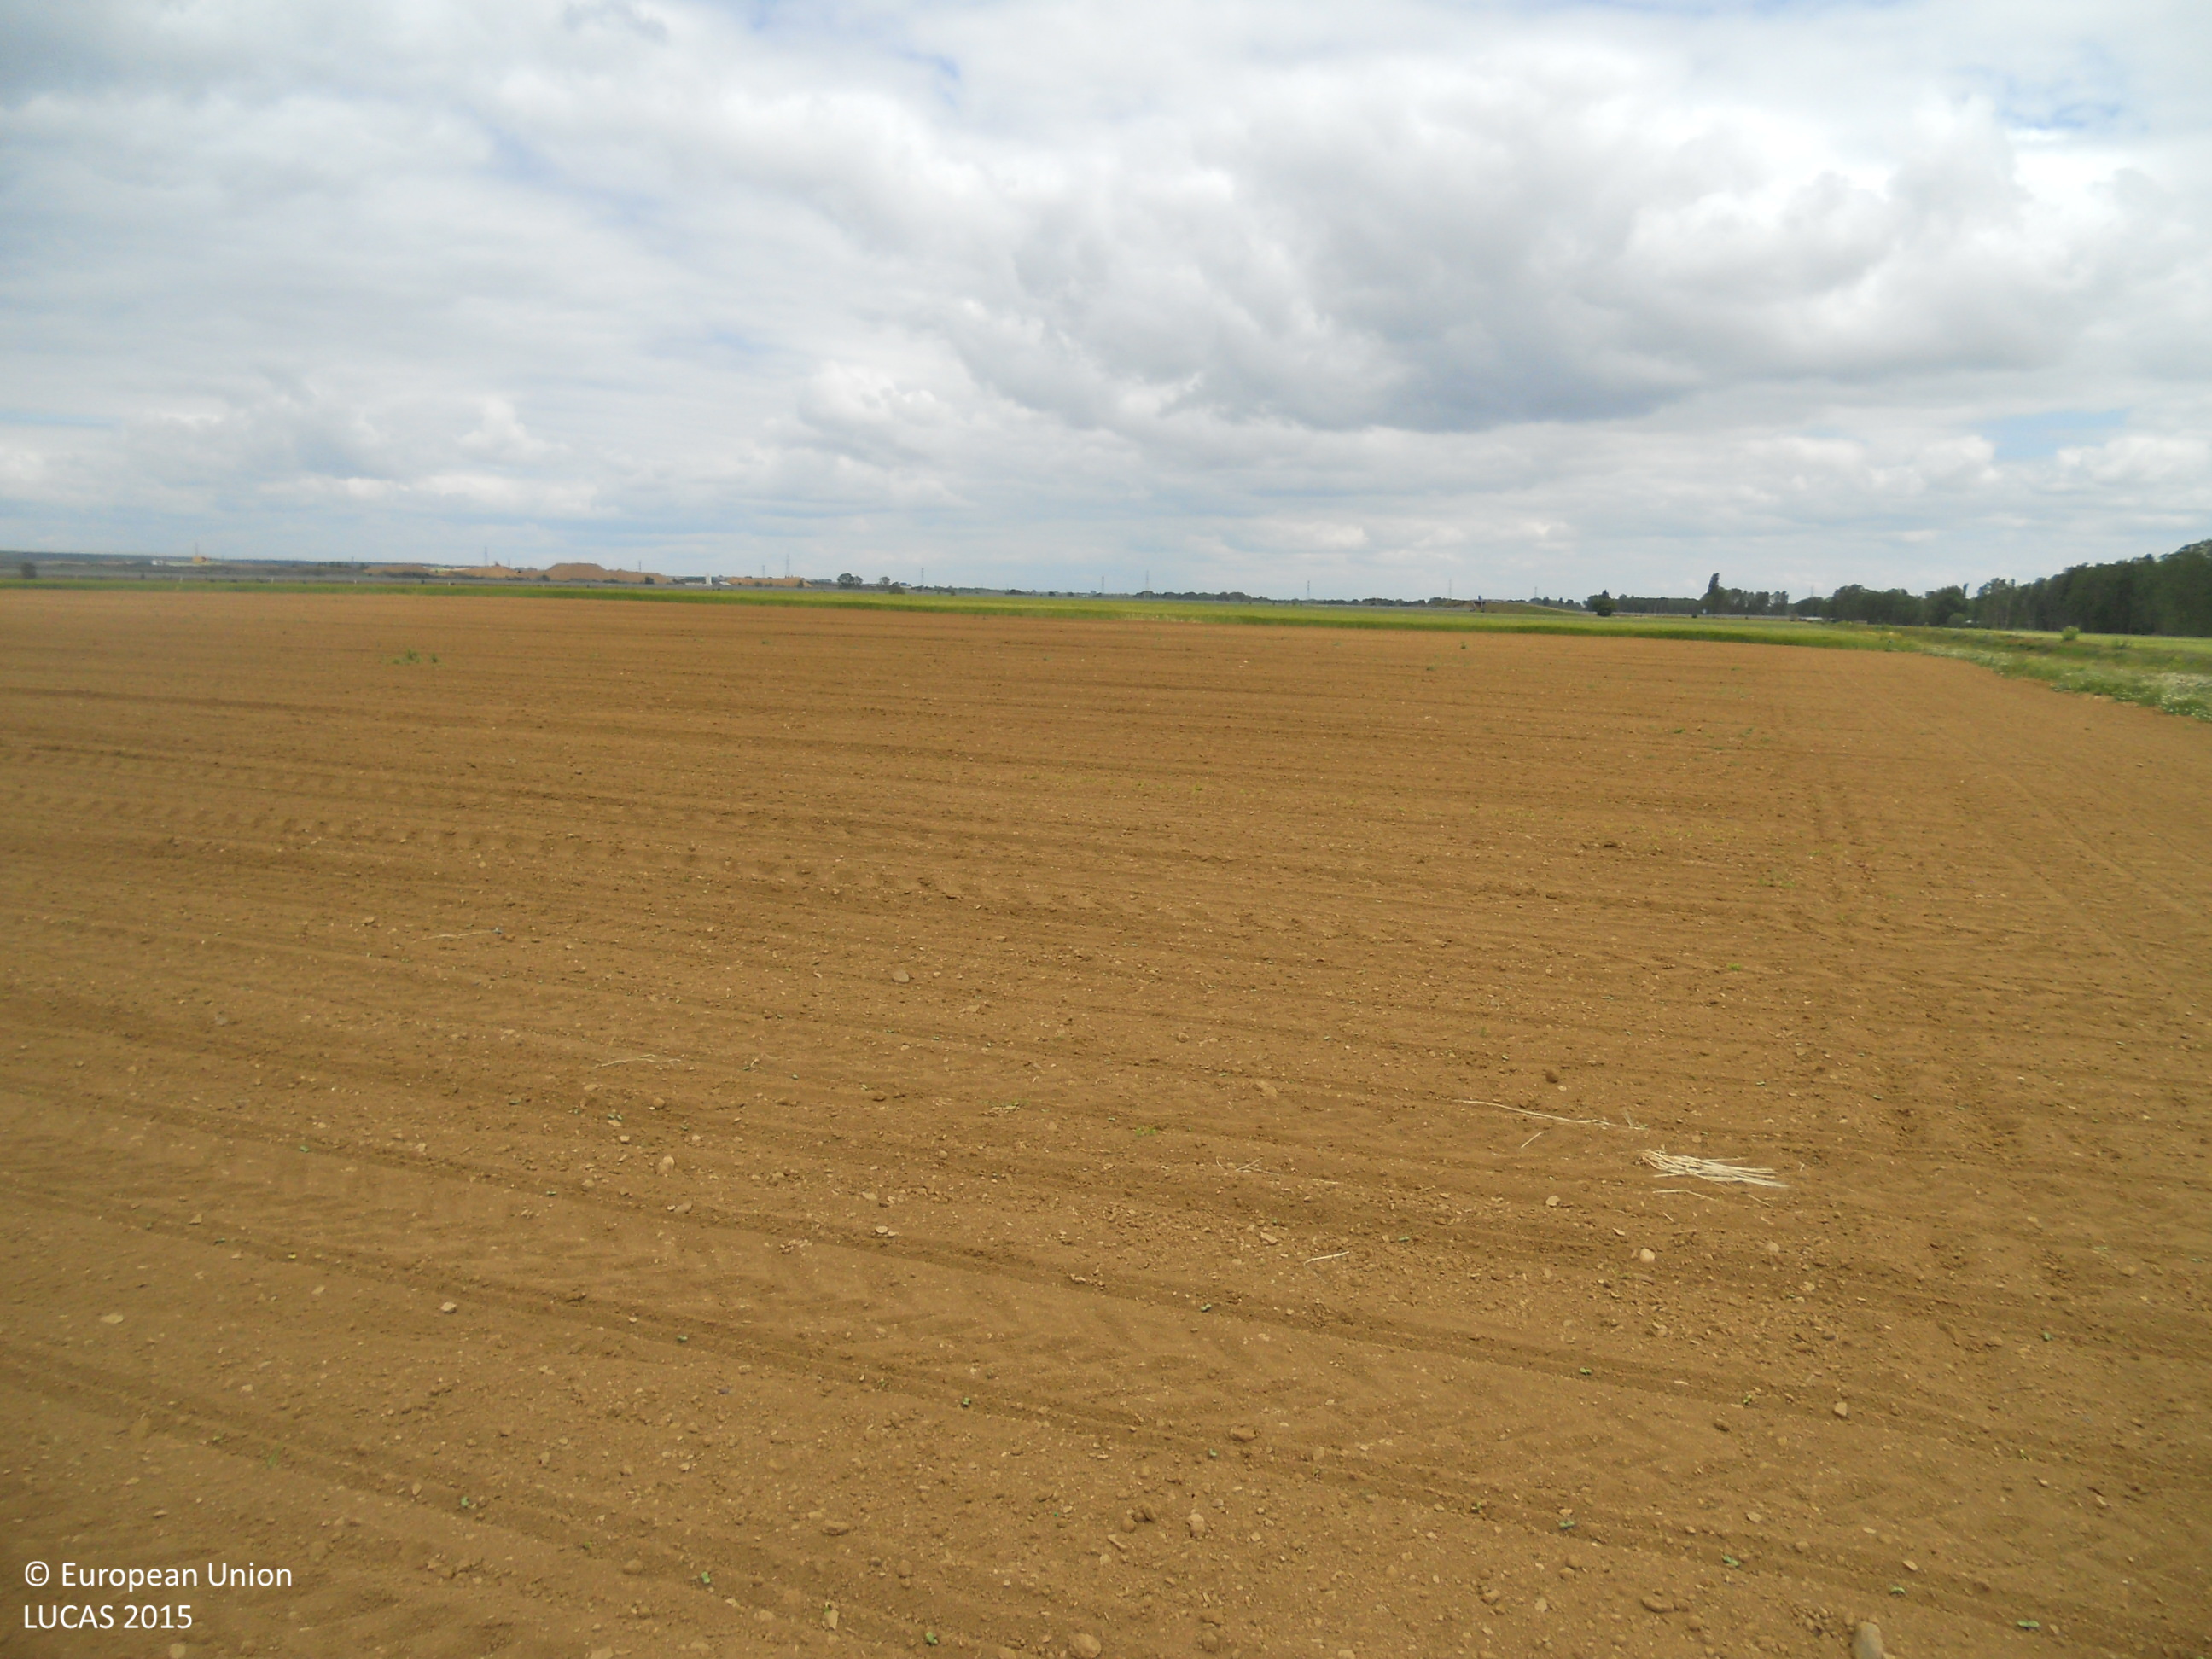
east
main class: Cropland
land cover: Sunflower
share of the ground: < 10 %
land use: Agriculture (excluding fallow land and kitchen gardens)
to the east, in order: Sunflower; Barley; Common wheat
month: May
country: ES
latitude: 42.4244
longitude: -4.4023
